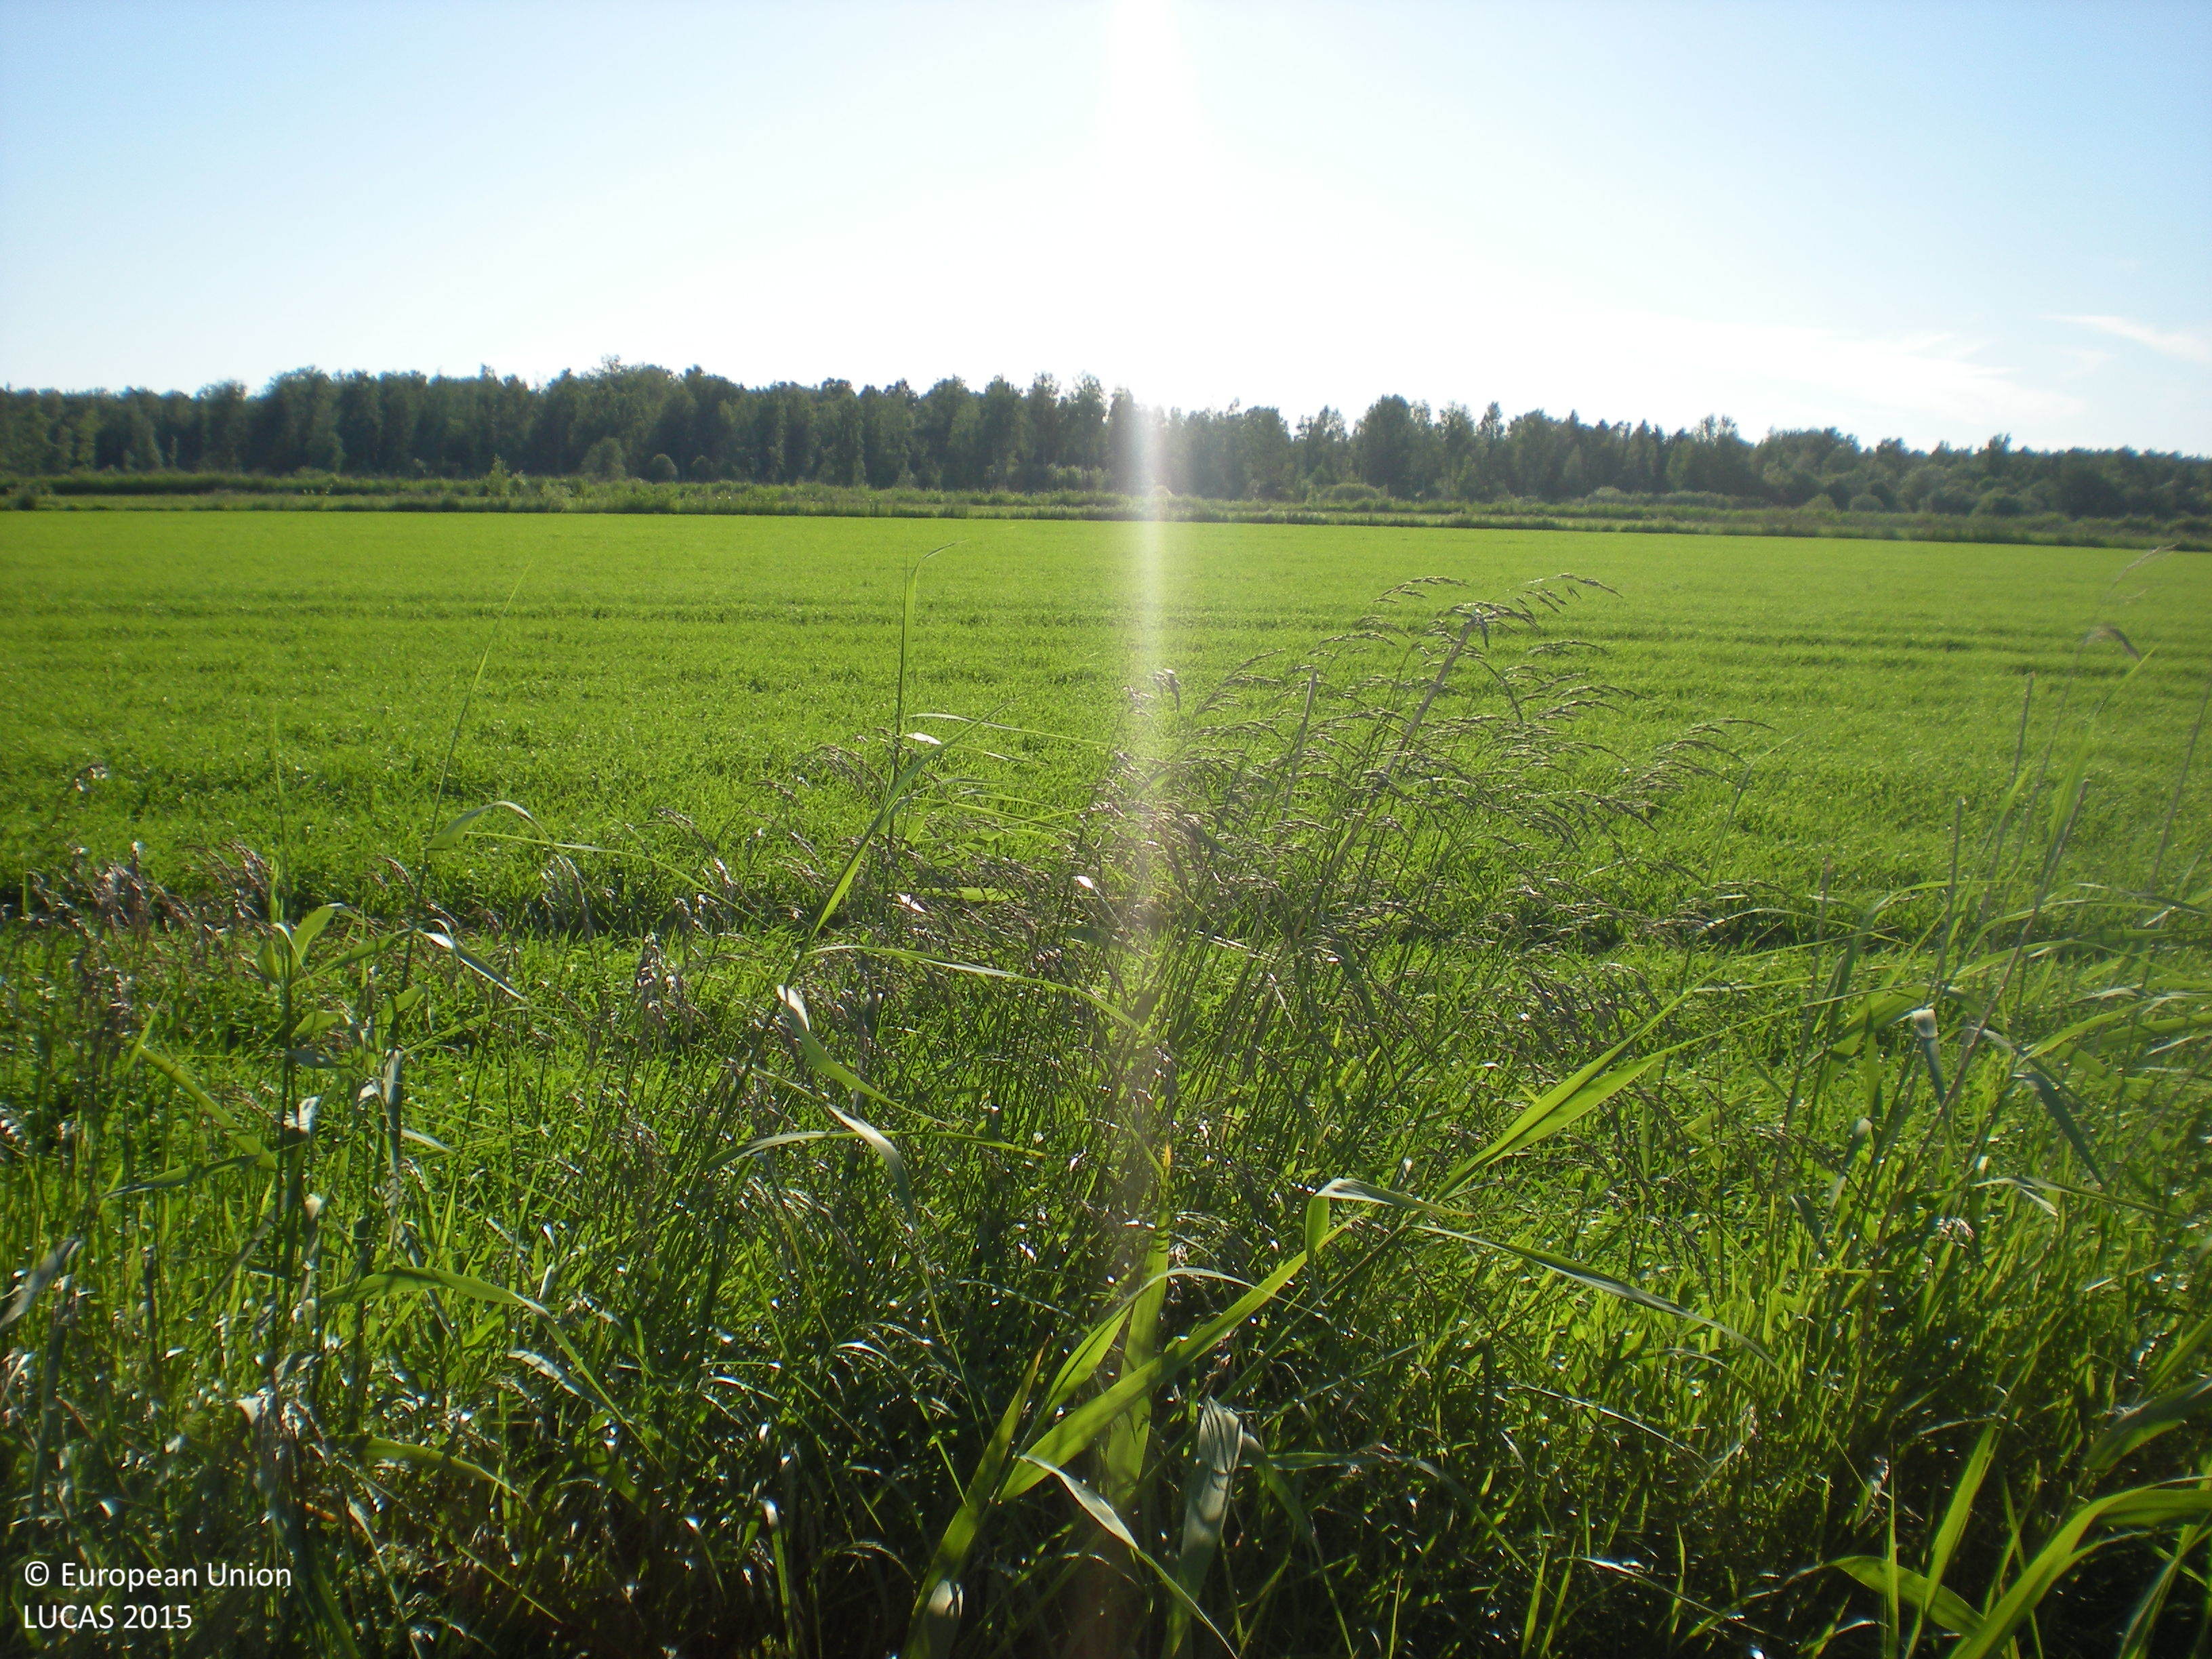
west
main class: Cropland
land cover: Barley
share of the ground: > 75 %
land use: Agriculture (excluding fallow land and kitchen gardens)
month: July
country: SE
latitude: 60.4955
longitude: 17.6914
